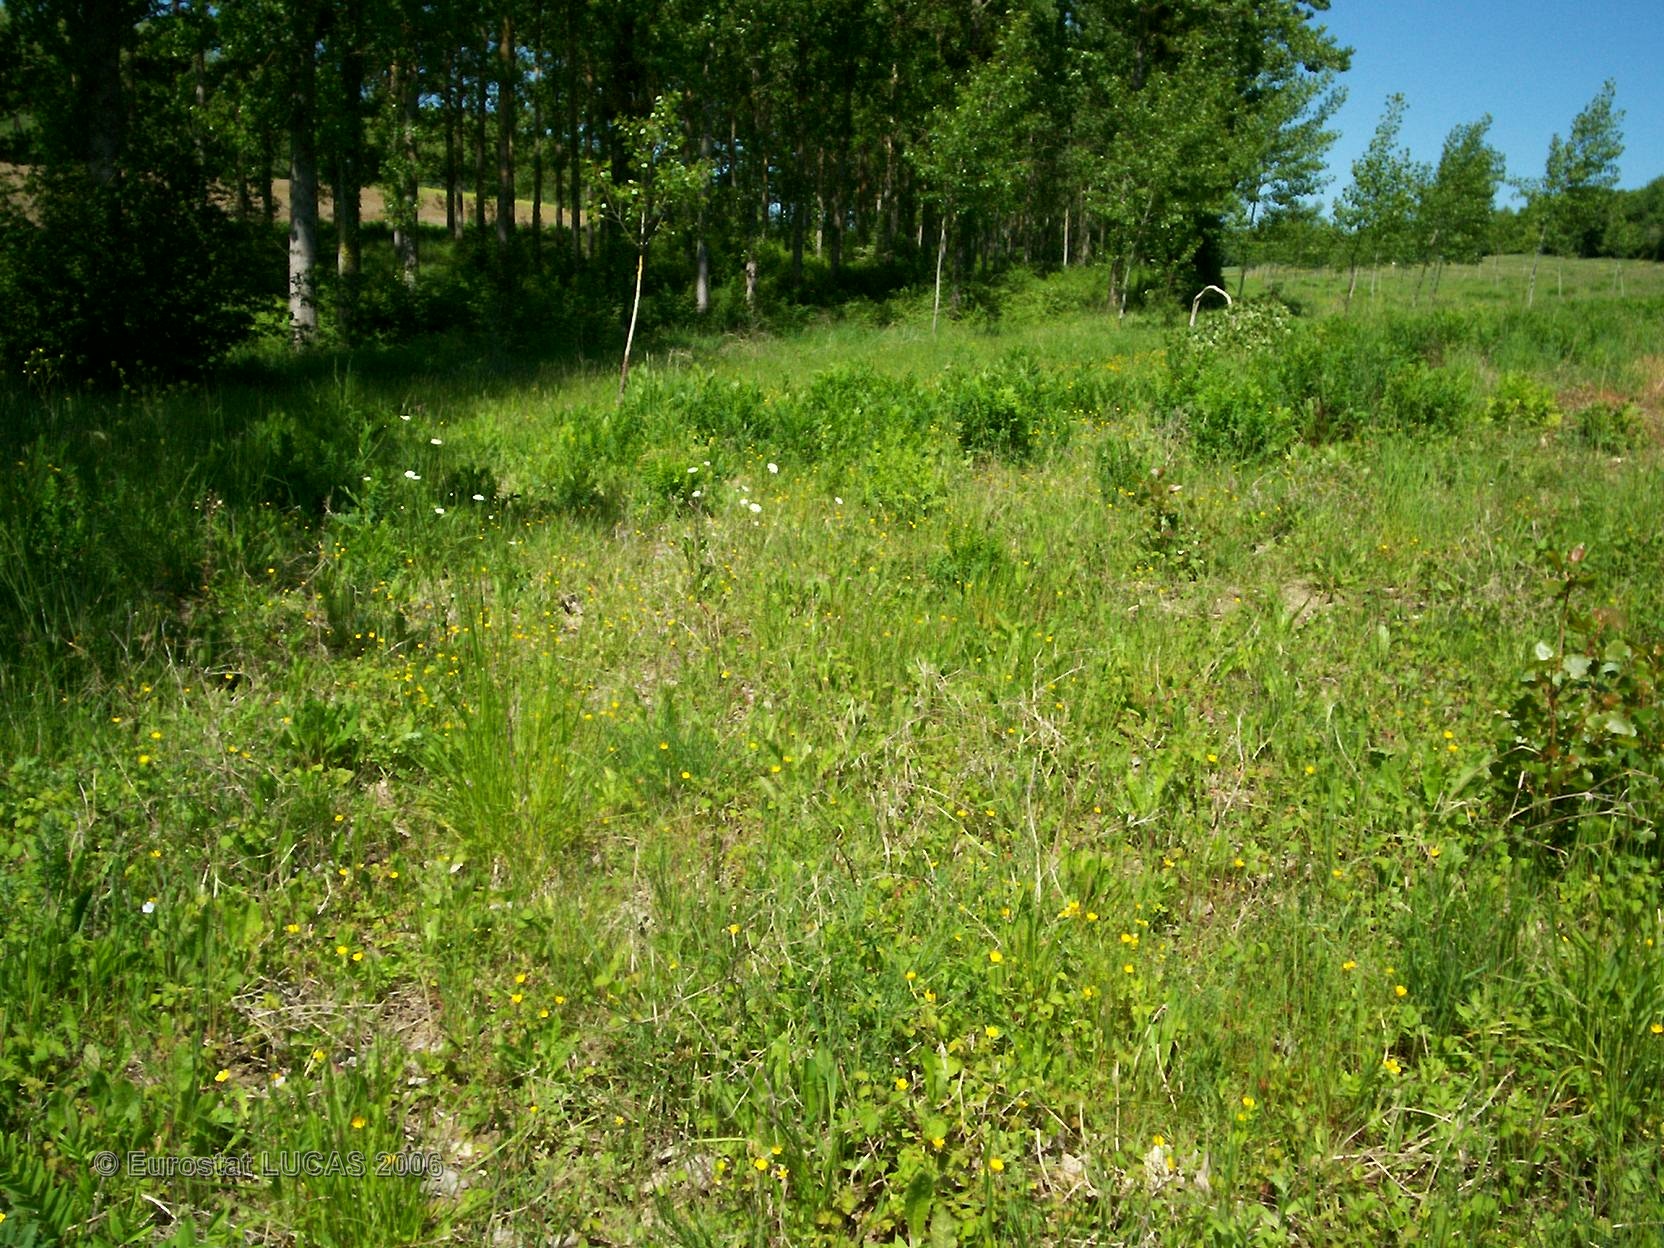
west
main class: Grassland
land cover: Grassland without tree/shrub cover
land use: Agriculture (excluding fallow land and kitchen gardens)
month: May
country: FR
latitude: 43.1529
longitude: 0.9149
